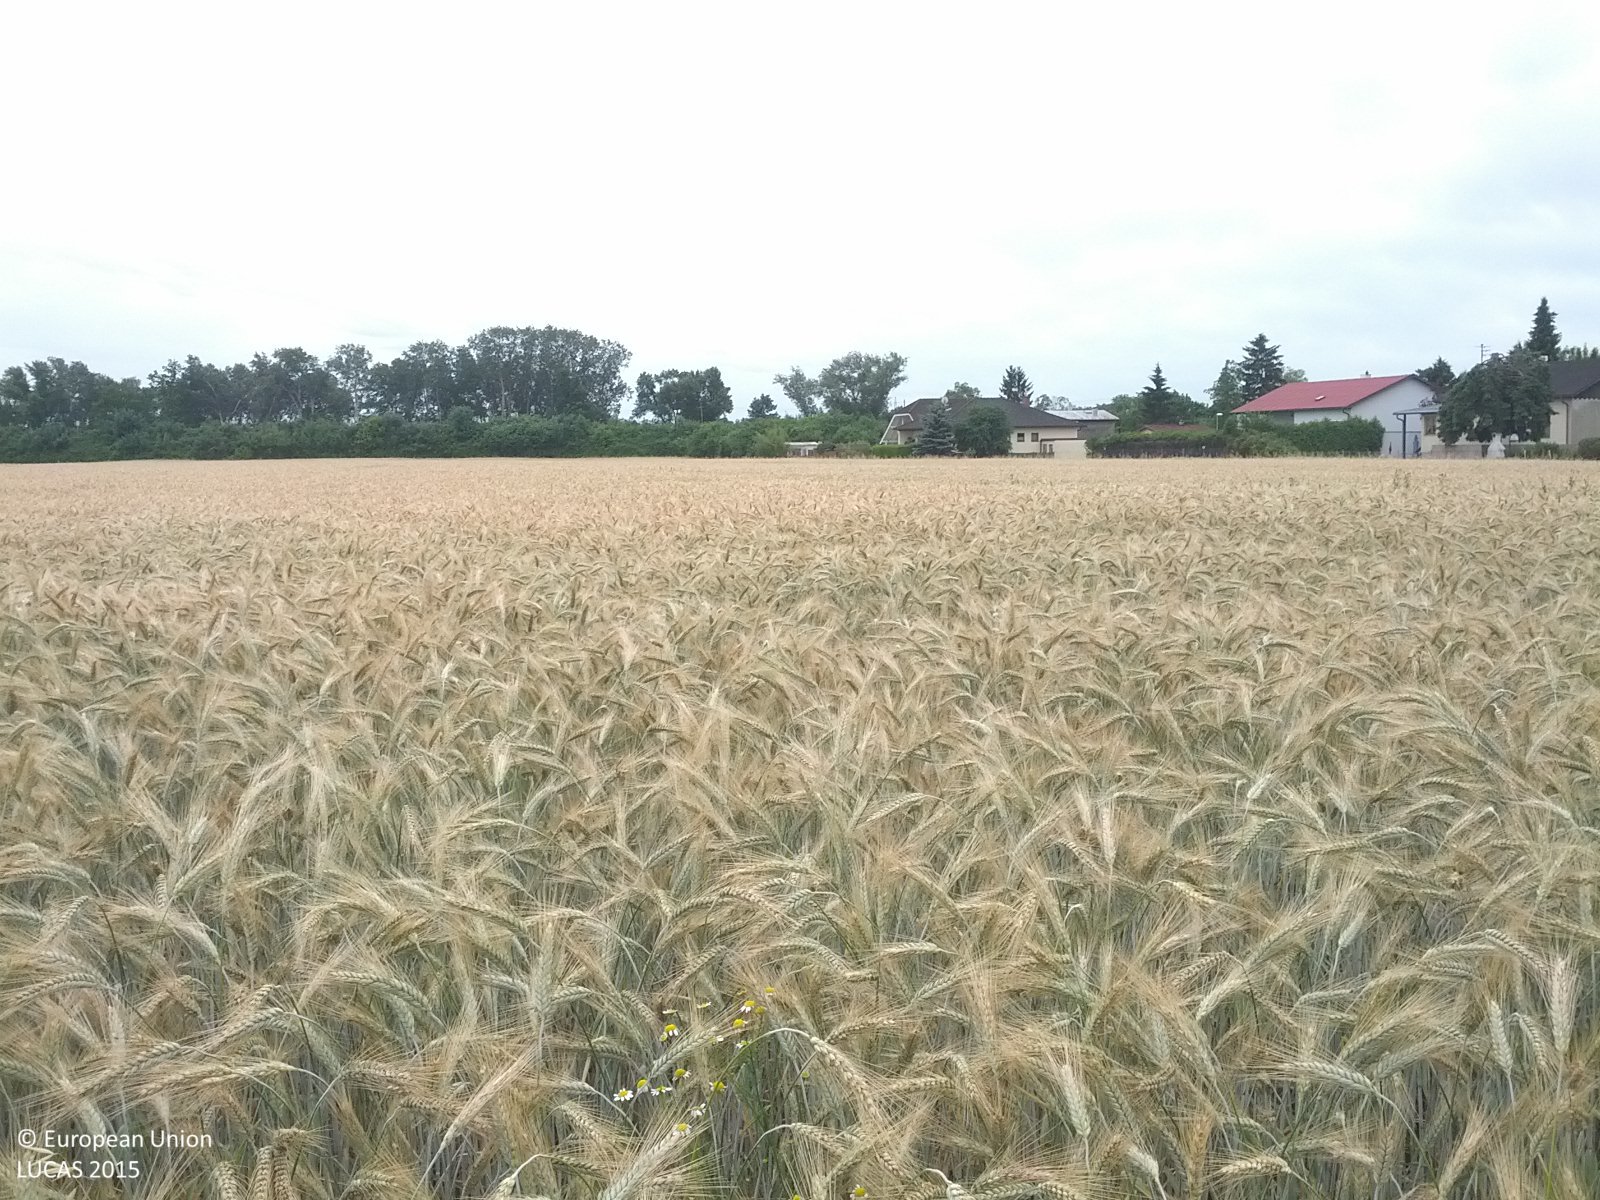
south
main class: Cropland
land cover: Rye
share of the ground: > 75 %
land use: Agriculture (excluding fallow land and kitchen gardens)
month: June
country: AT
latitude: 48.3406
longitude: 16.7660
